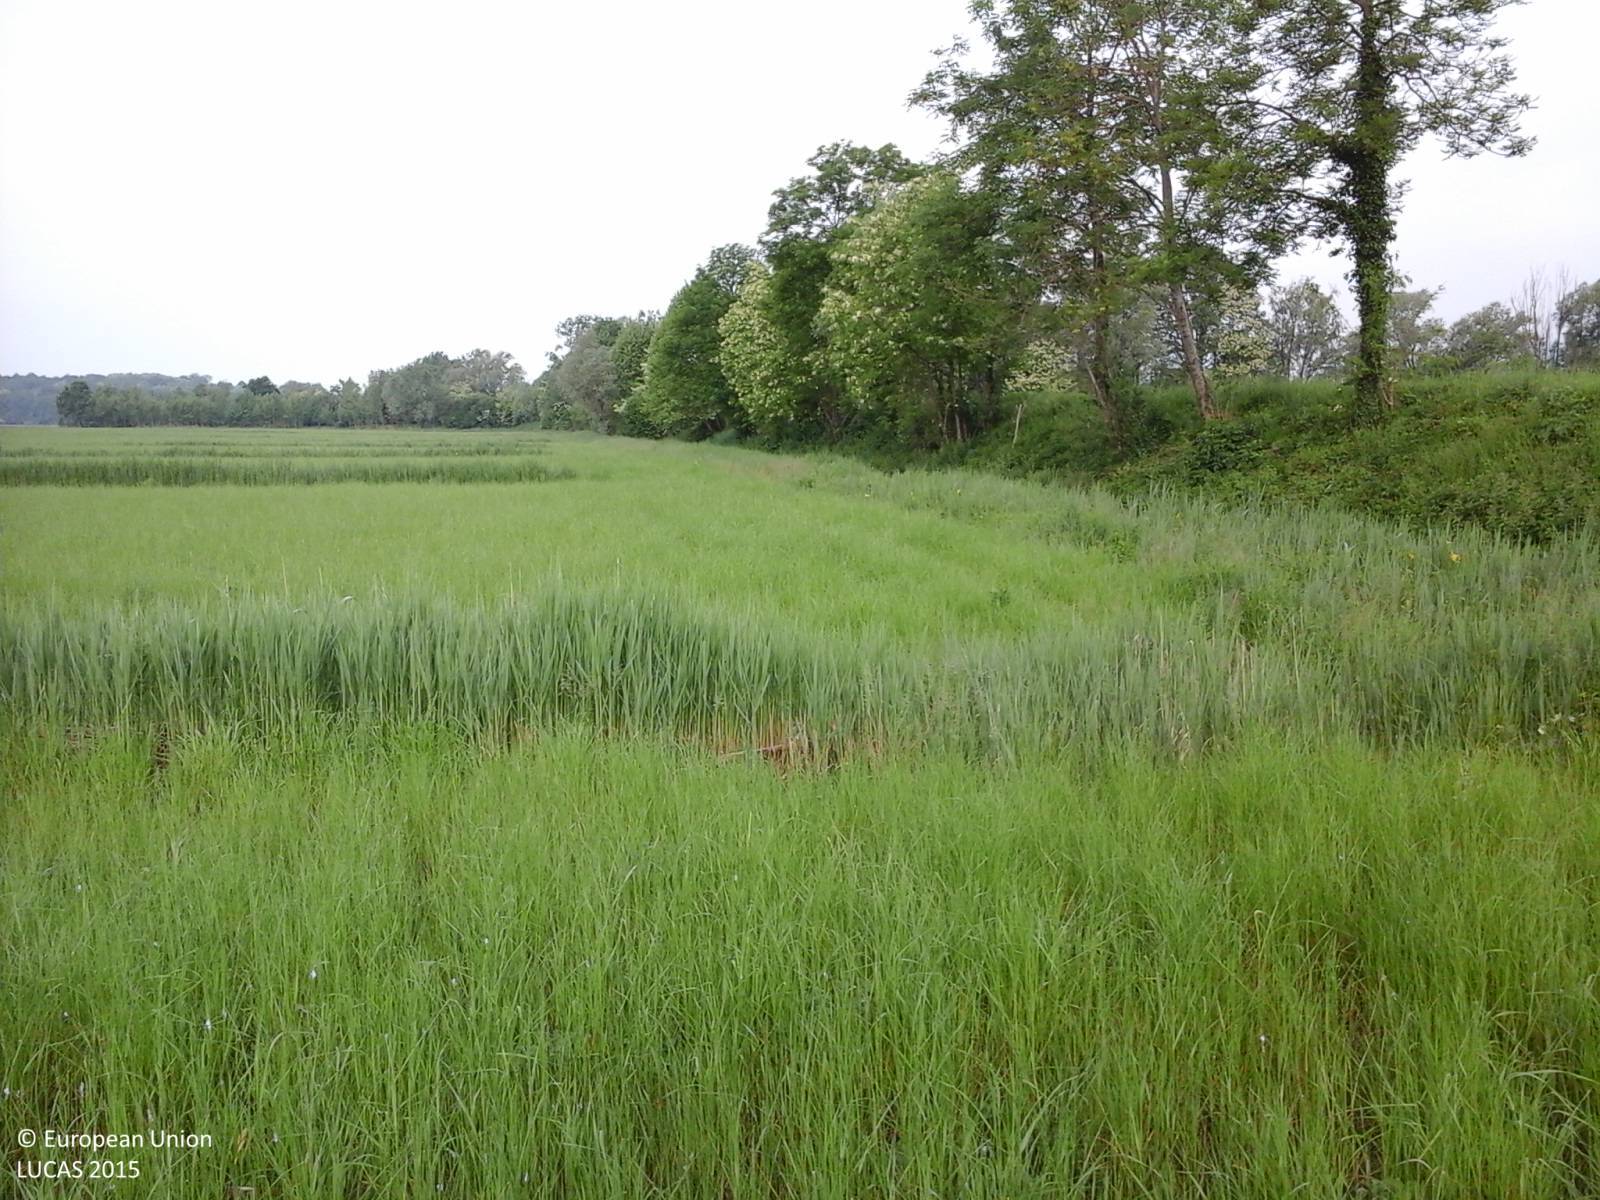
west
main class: Cropland
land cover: Temporary grasslands
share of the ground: > 75 %
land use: Agriculture (excluding fallow land and kitchen gardens)
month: May
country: IT
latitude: 46.1631
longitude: 13.0659
